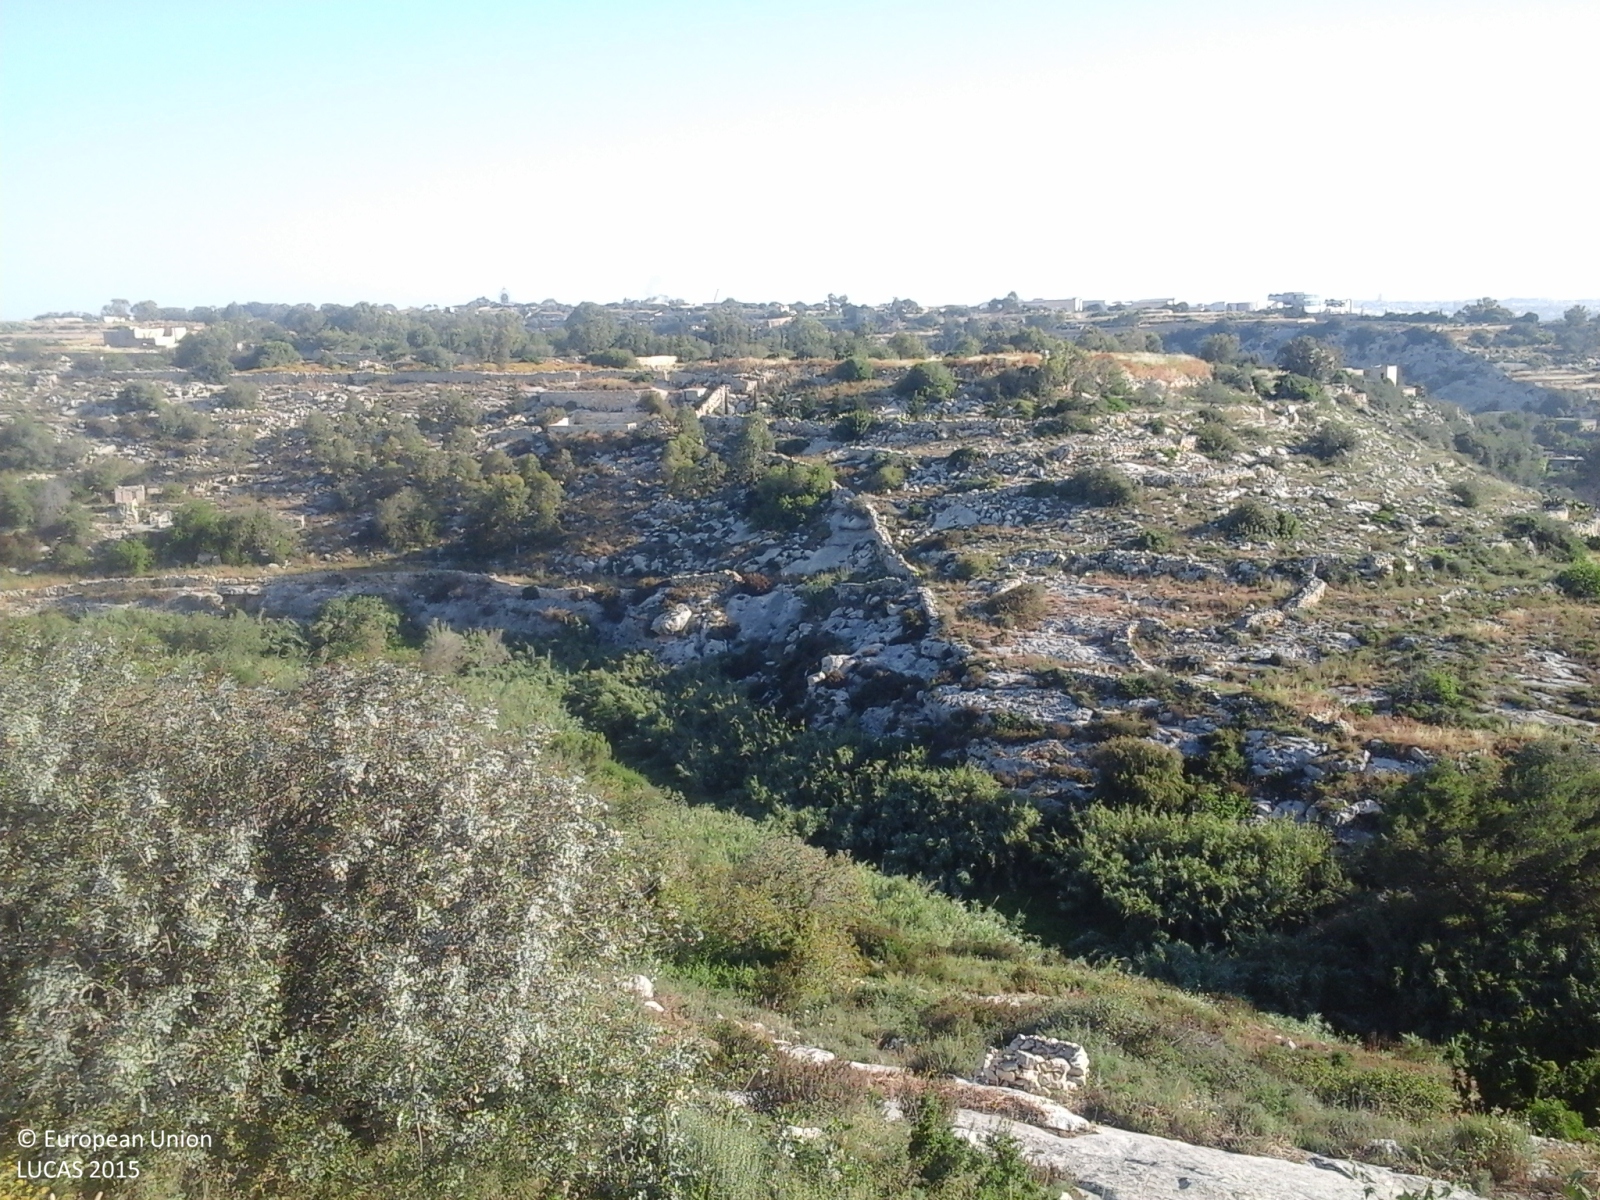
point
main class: Shrubland
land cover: Shrubland with sparse tree cover
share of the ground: > 75 %
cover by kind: shrubs 65 %, herbaceous plants 20 %, coniferous forest trees 5 %
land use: Semi-natural and natural areas not in use
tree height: > 5 m
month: May
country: MT
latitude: 35.8592
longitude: 14.4656
